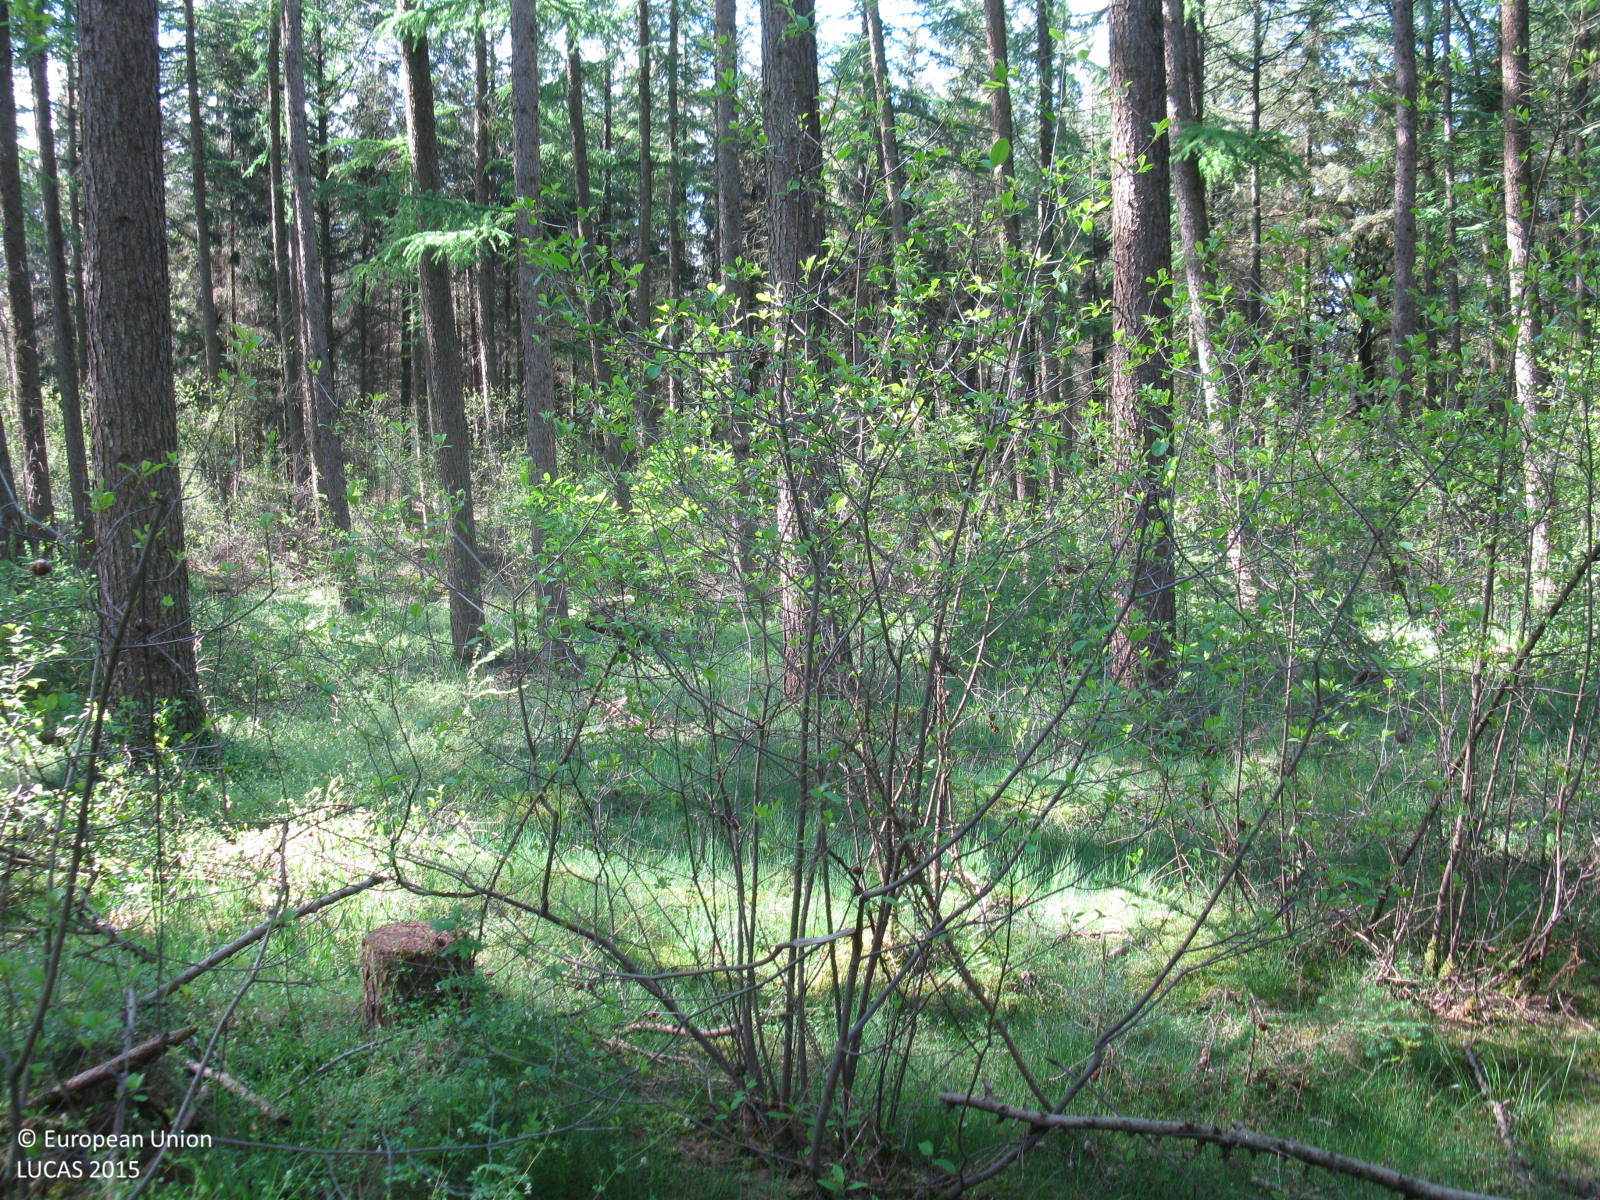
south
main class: Woodland
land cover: Other coniferous woodland
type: hemiboreal forest and nemoral coniferous forest and mixed broadleaved-coniferous forest
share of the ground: > 75 %
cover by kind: coniferous forest trees 100 %
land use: Forestry
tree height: > 5 m
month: May
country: DE
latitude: 52.8147
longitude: 7.3149
